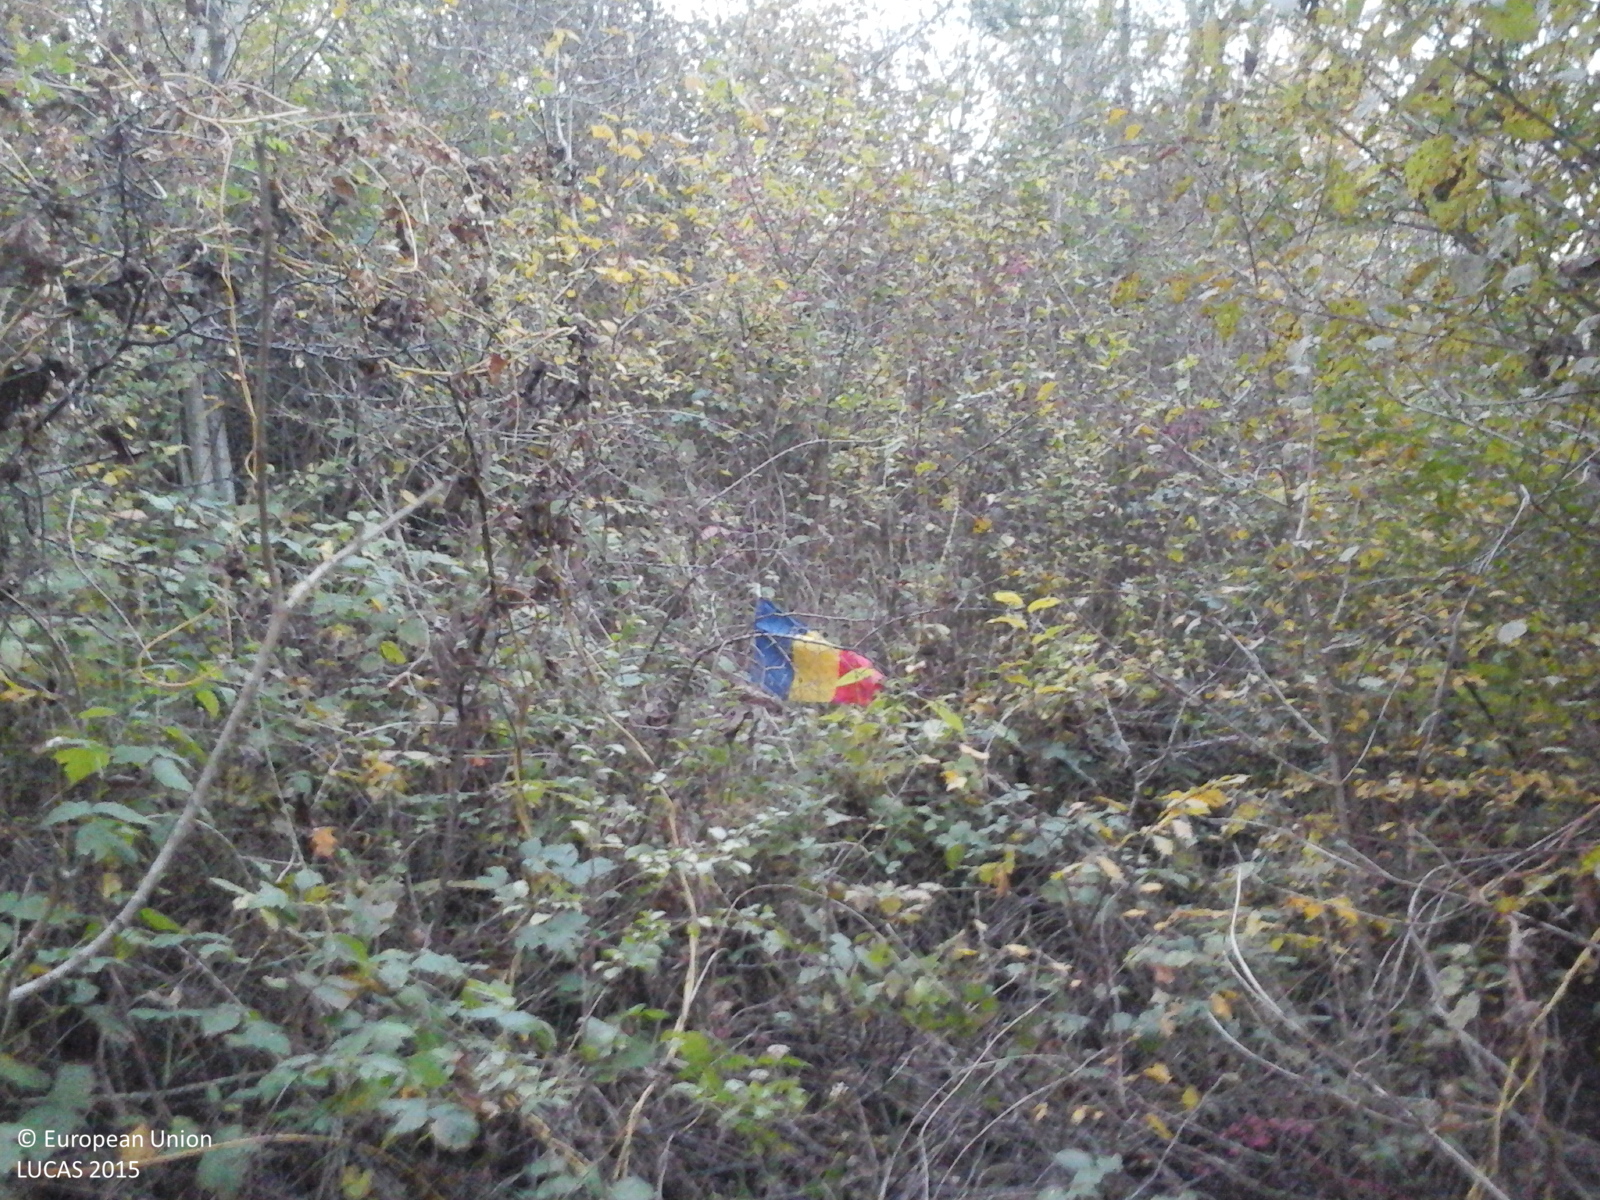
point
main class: Shrubland
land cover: Shrubland with sparse tree cover
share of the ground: > 75 %
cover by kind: shrubs 85 %, herbaceous plants 10 %, broadleaved forest trees 5 %
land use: Semi-natural and natural areas not in use
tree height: < 5 m
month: October
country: RO
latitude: 45.3562
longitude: 26.4758
